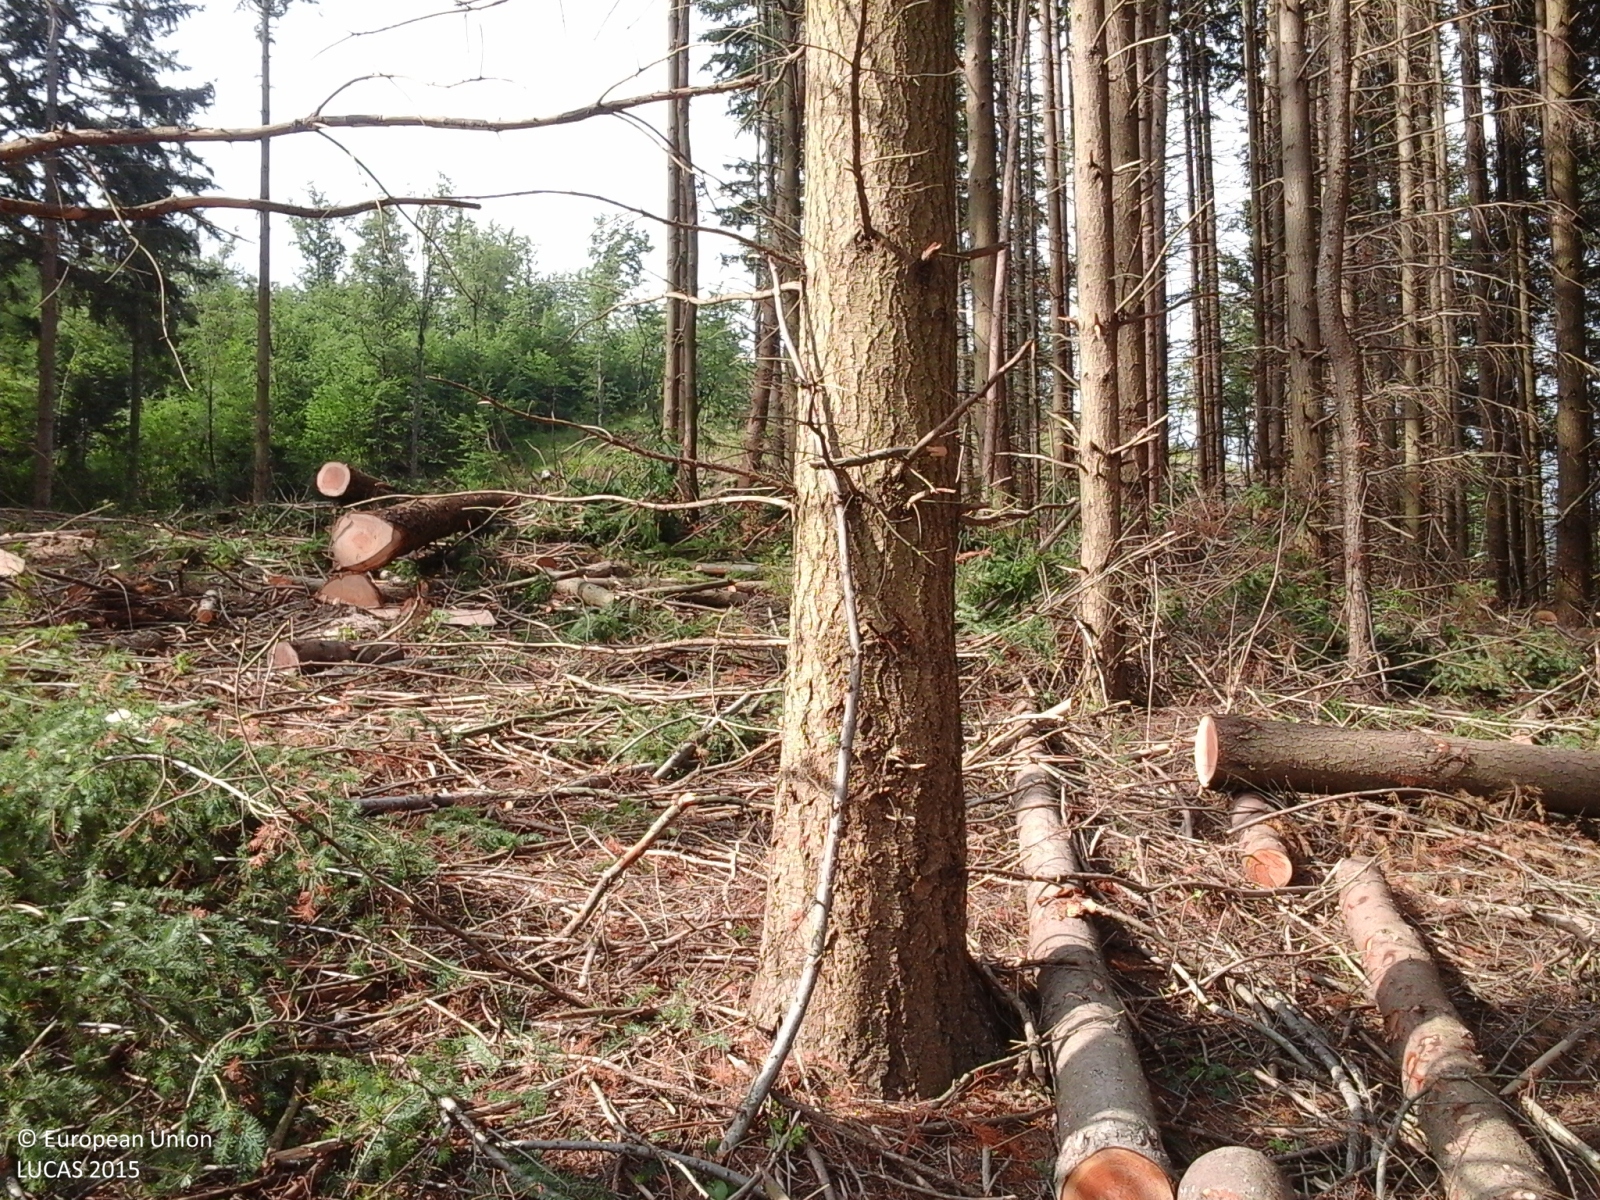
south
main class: Woodland
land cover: Other coniferous woodland
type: coniferous forest of the mediterranean region
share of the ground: > 75 %
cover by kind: coniferous forest trees 80 %, broadleaved forest trees 20 %
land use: Forestry
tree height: > 5 m
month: June
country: IT
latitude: 43.8507
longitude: 11.6255
